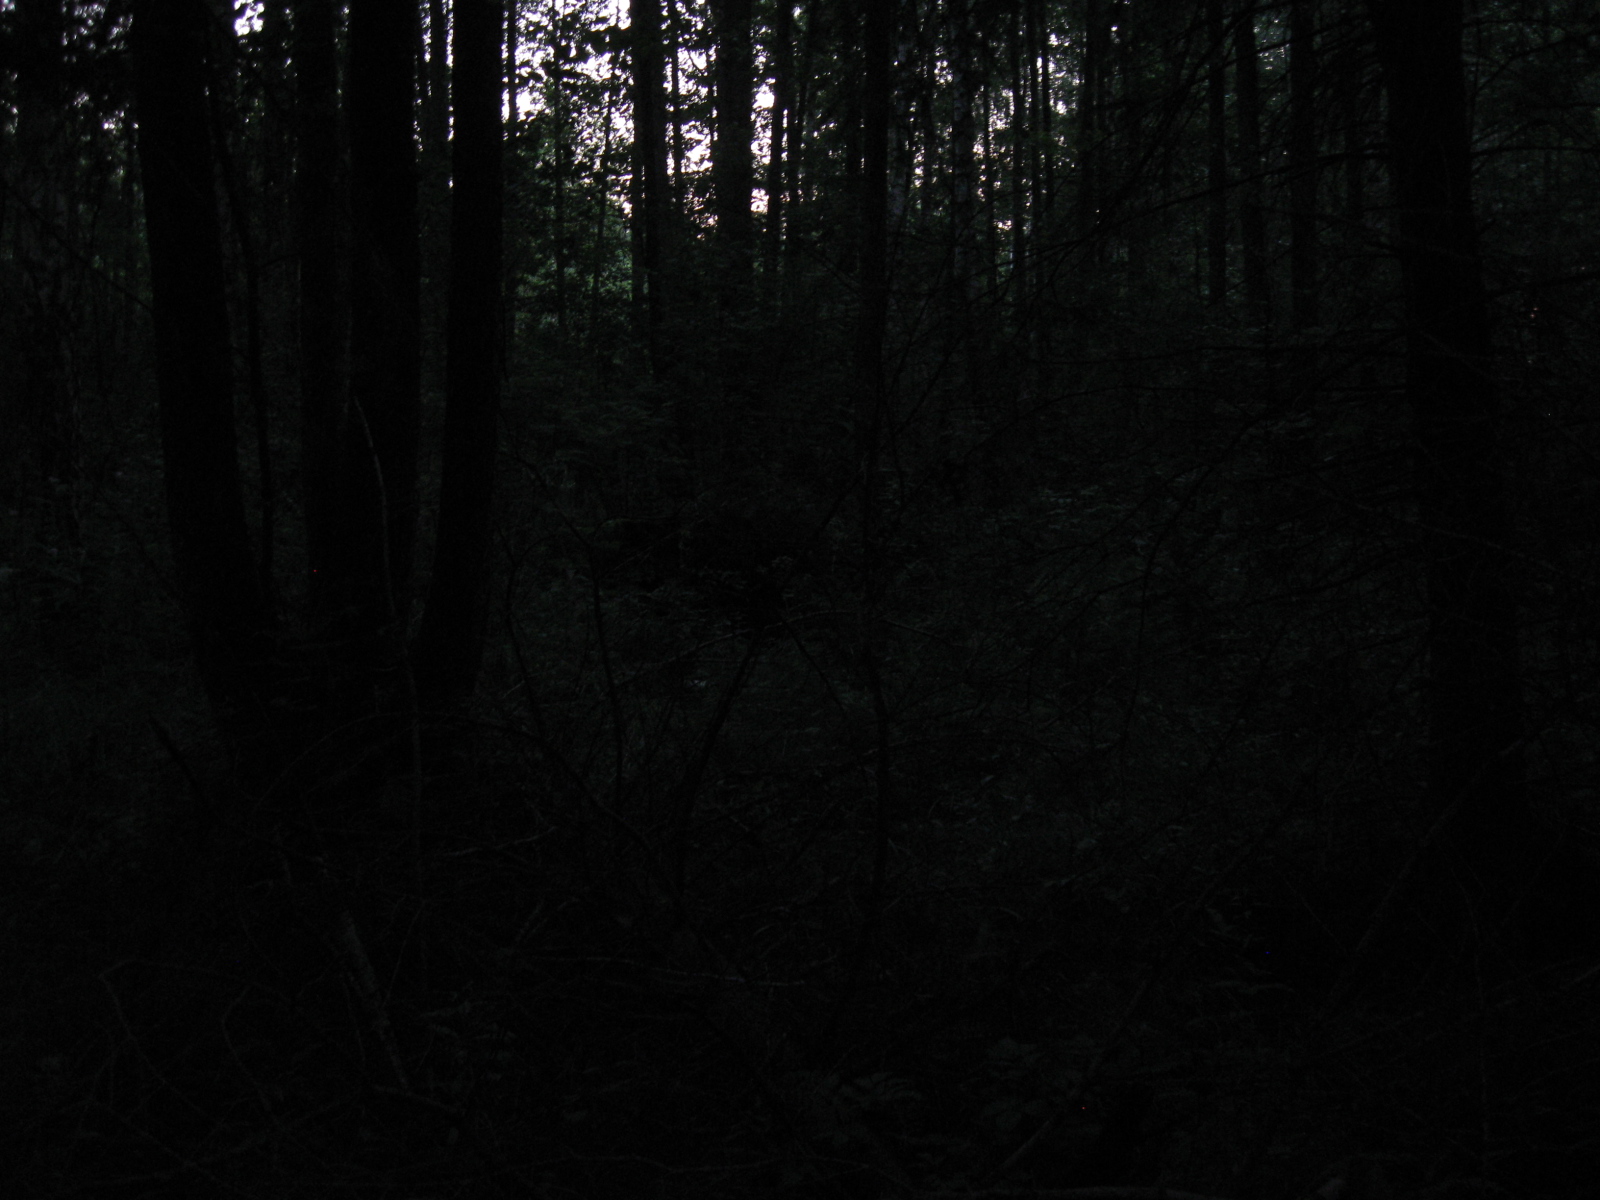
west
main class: Woodland
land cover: Other mixed woodland
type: hemiboreal forest and nemoral coniferous forest and mixed broadleaved-coniferous forest
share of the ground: > 75 %
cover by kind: broadleaved forest trees 65 %, coniferous forest trees 30 %, herbaceous plants 5 %
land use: Forestry
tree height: > 5 m
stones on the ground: < 10 %
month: August
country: LT
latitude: 54.6312
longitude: 23.3231
